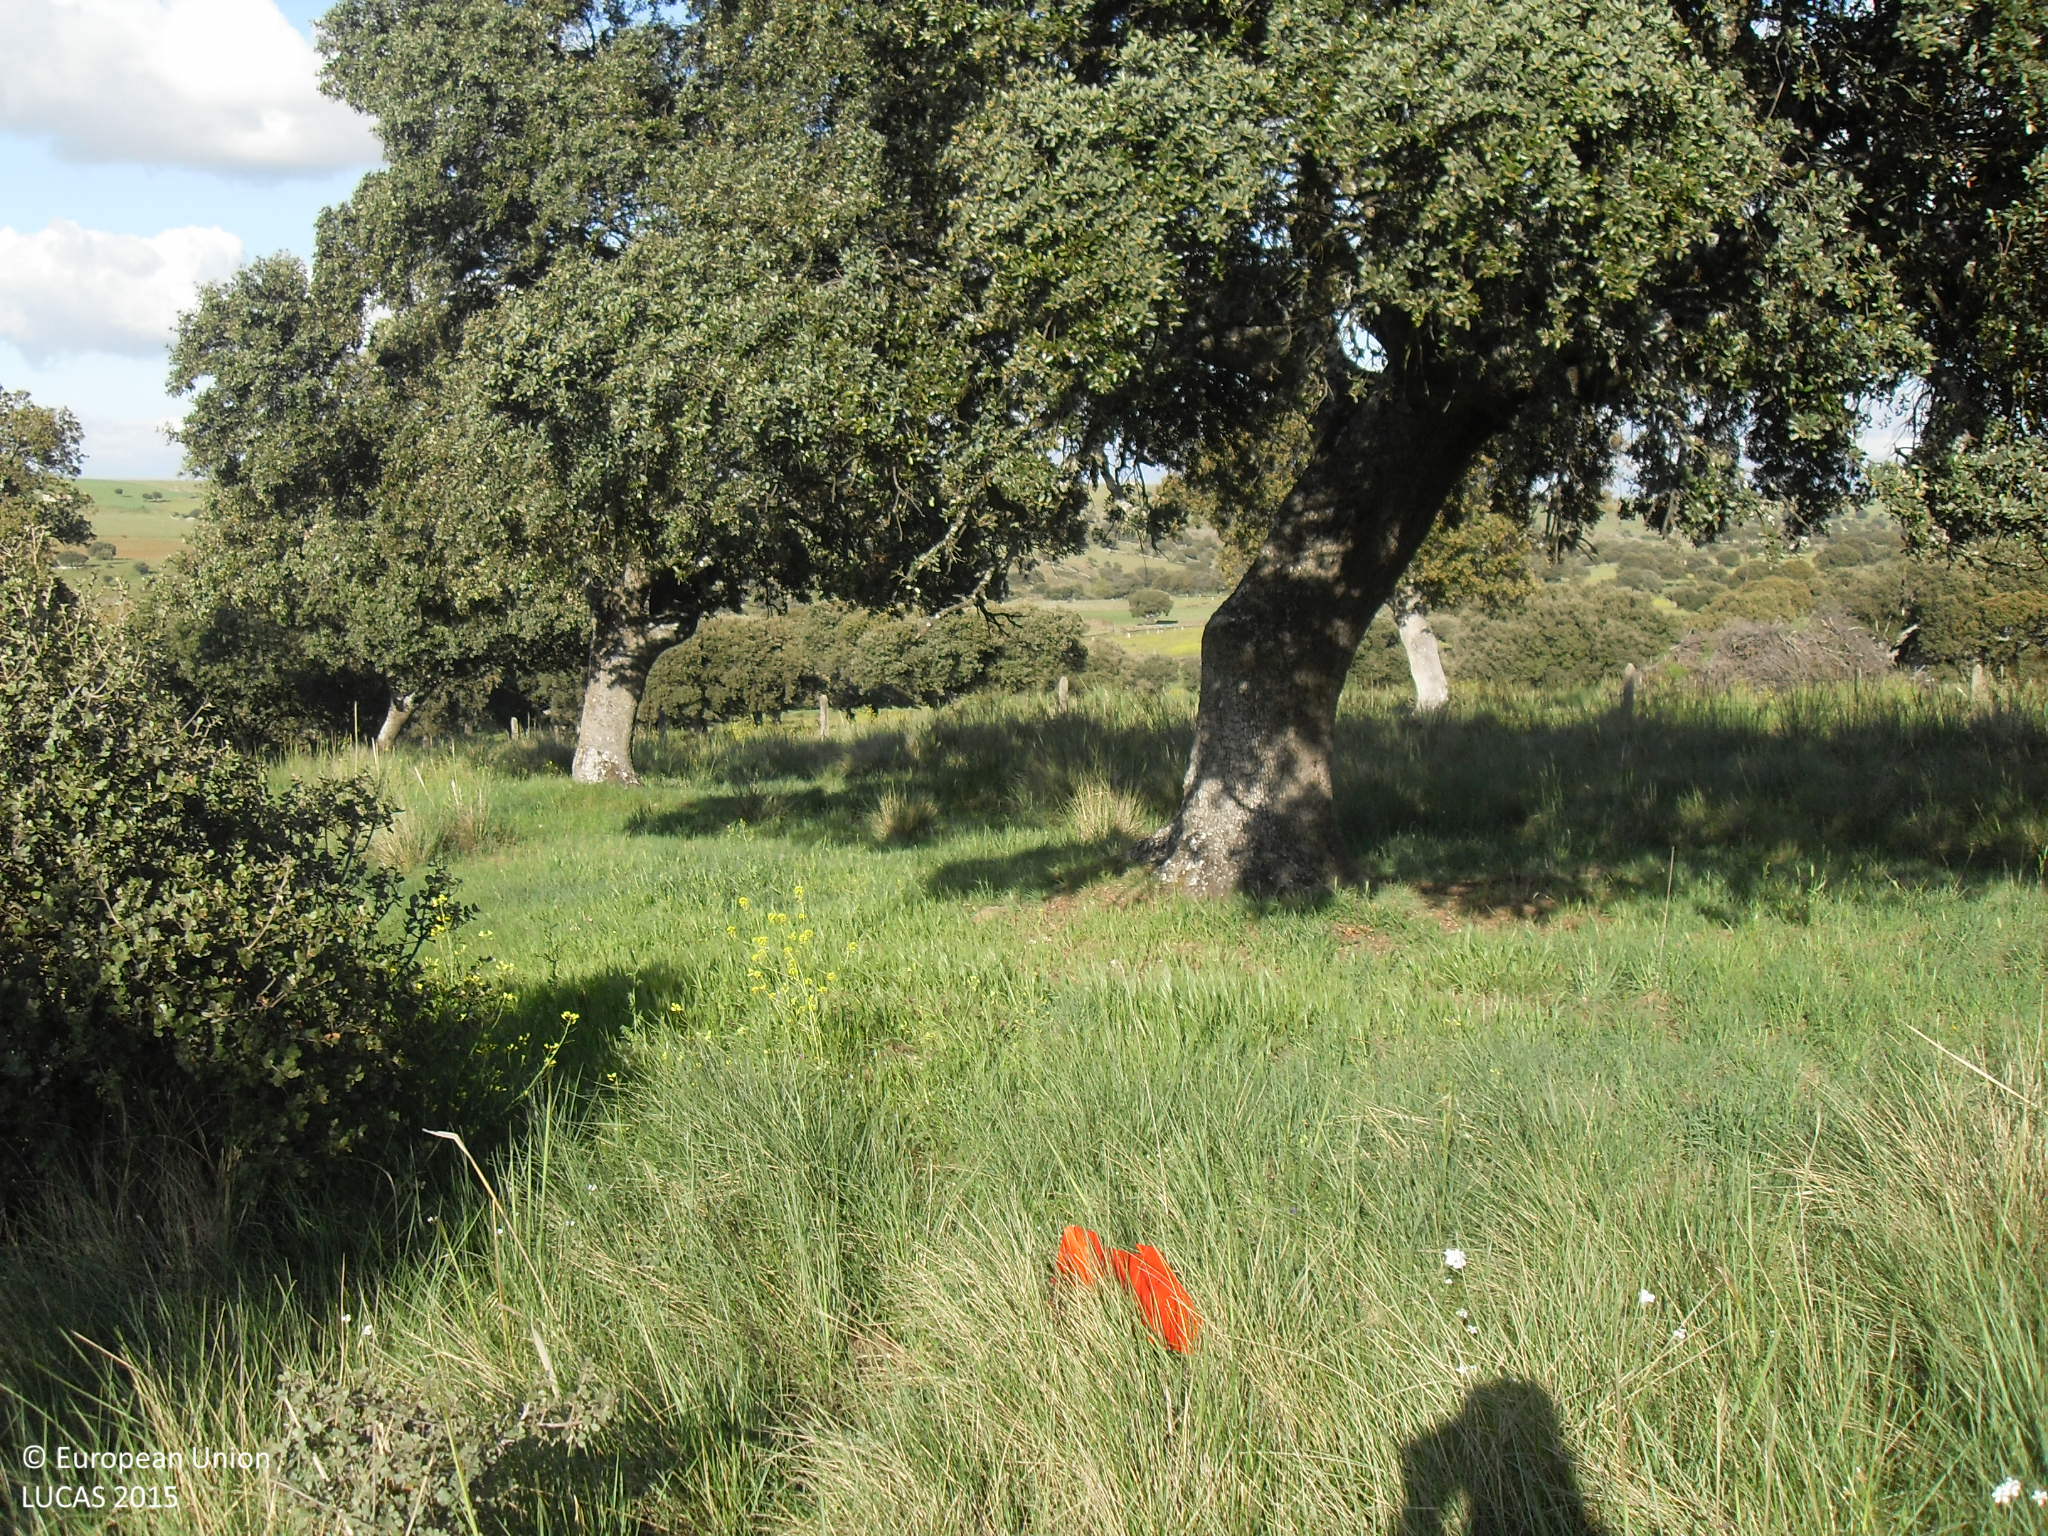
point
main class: Woodland
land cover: Broadleaved woodland
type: broadleaved evergreen forest
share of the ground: 10 - 25 %
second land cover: Grassland without tree/shrub cover
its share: > 75 %
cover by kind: herbaceous plants 80 %, broadleaved forest trees 20 %
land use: Forestry
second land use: Agriculture (excluding fallow land and kitchen gardens)
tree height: > 5 m
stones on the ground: < 10 %
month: May
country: ES
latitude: 40.6558
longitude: -5.3114
